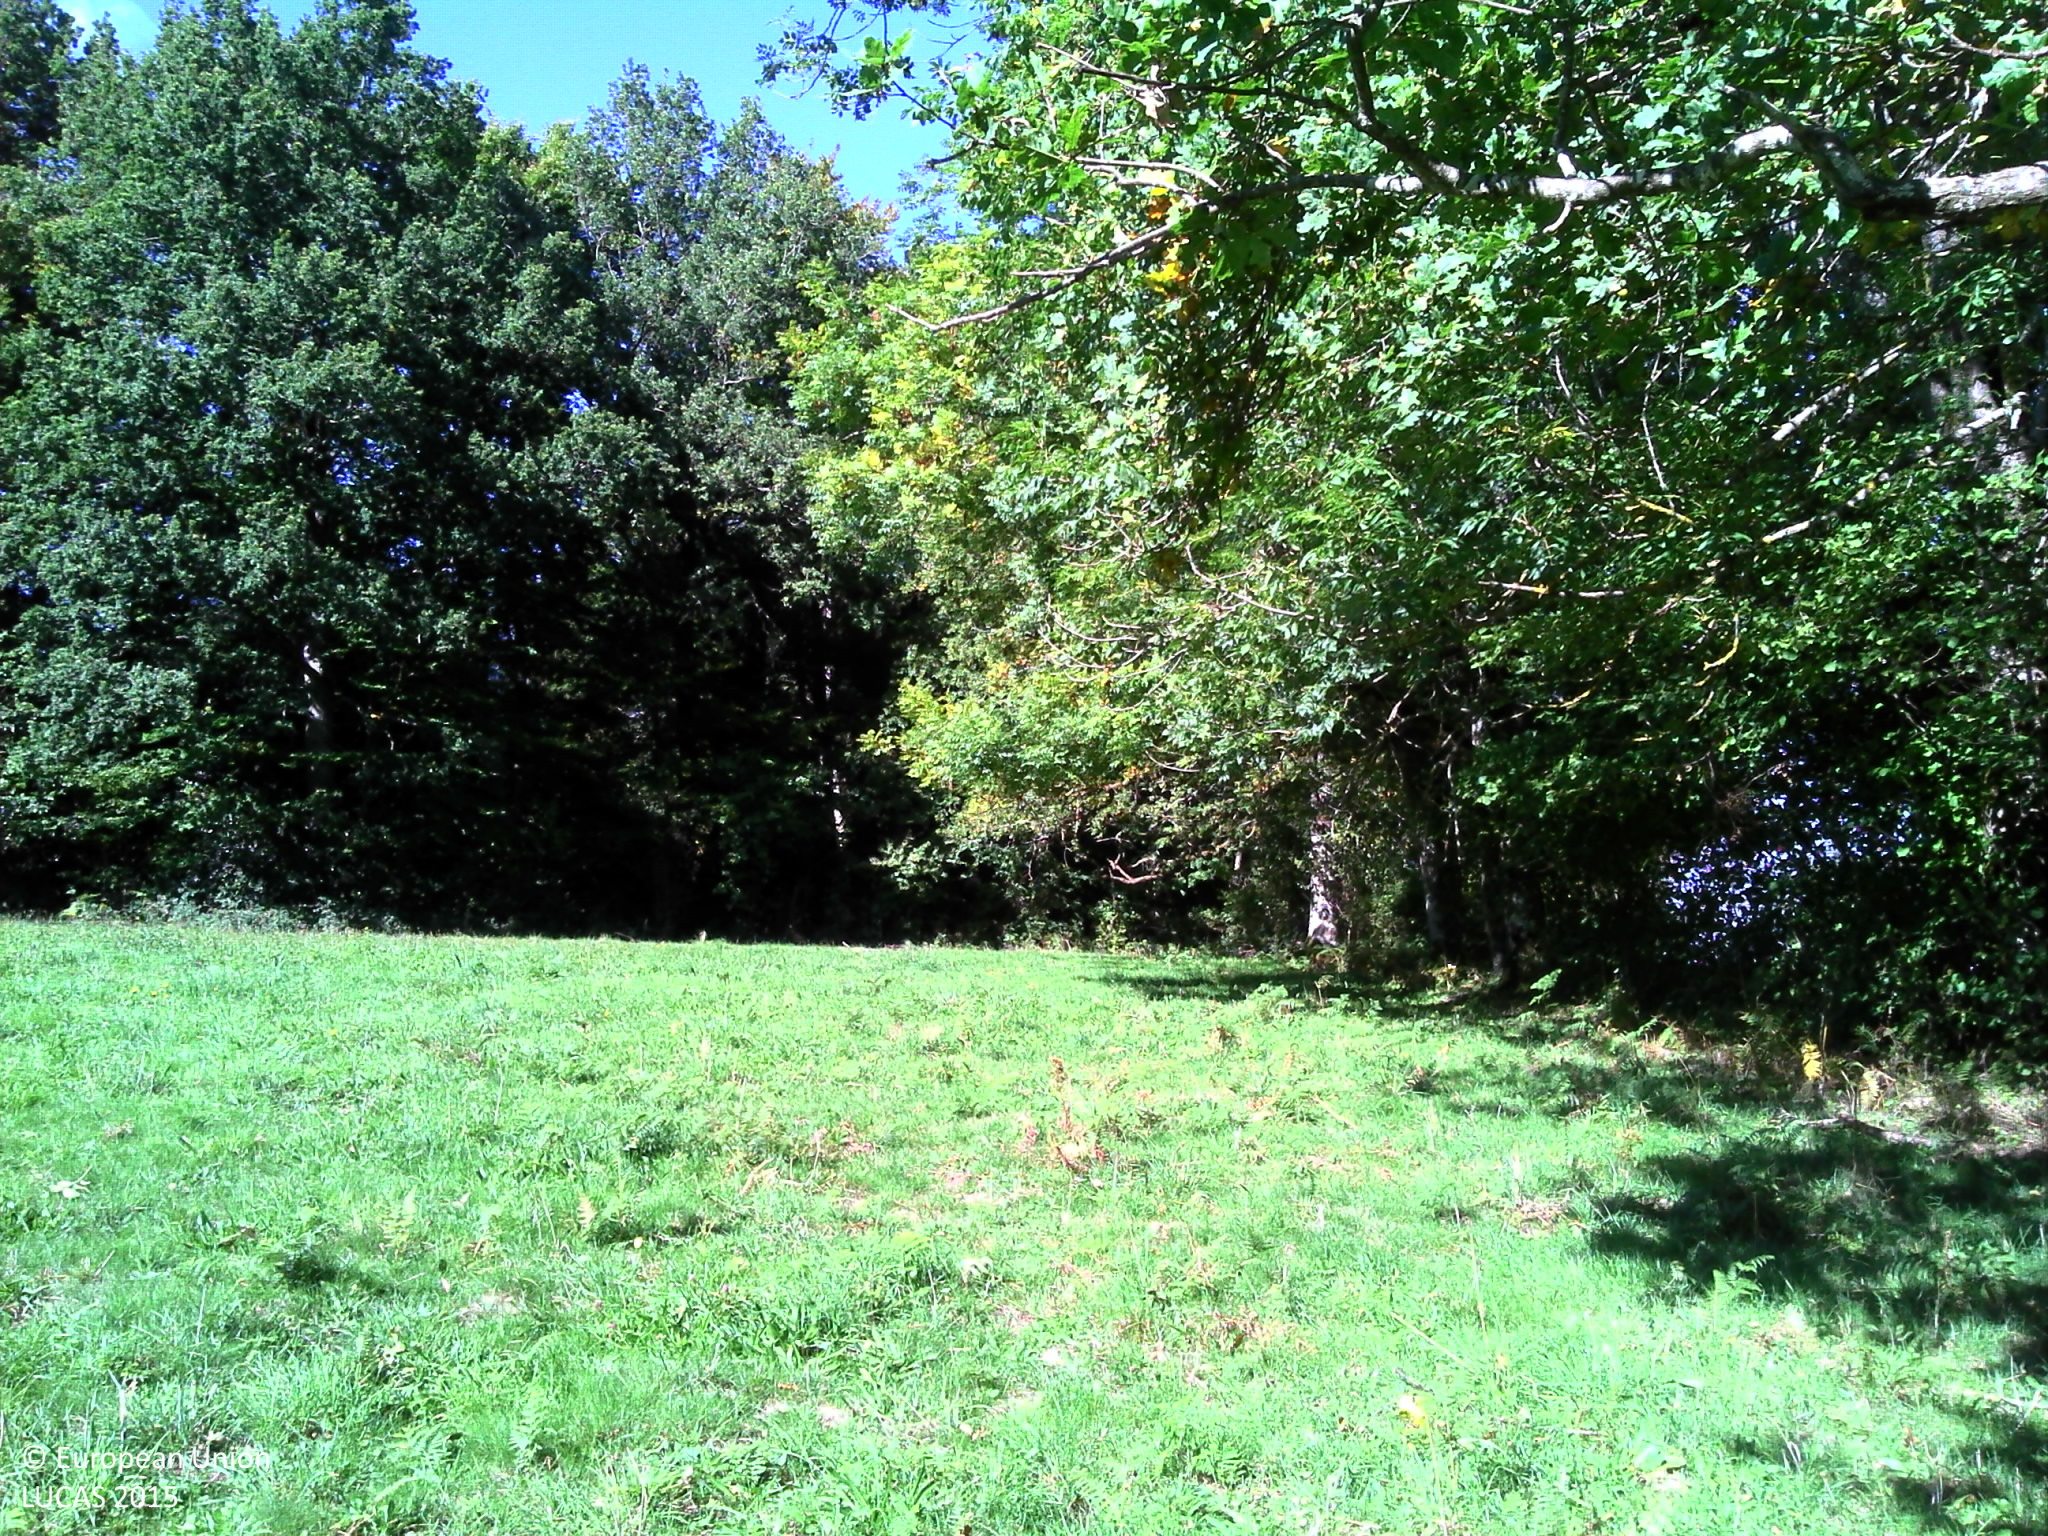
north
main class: Grassland
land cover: Grassland without tree/shrub cover
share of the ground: > 75 %
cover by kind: herbaceous plants 100 %
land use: Agriculture (excluding fallow land and kitchen gardens)
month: September
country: FR
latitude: 45.8373
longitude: 2.8015
